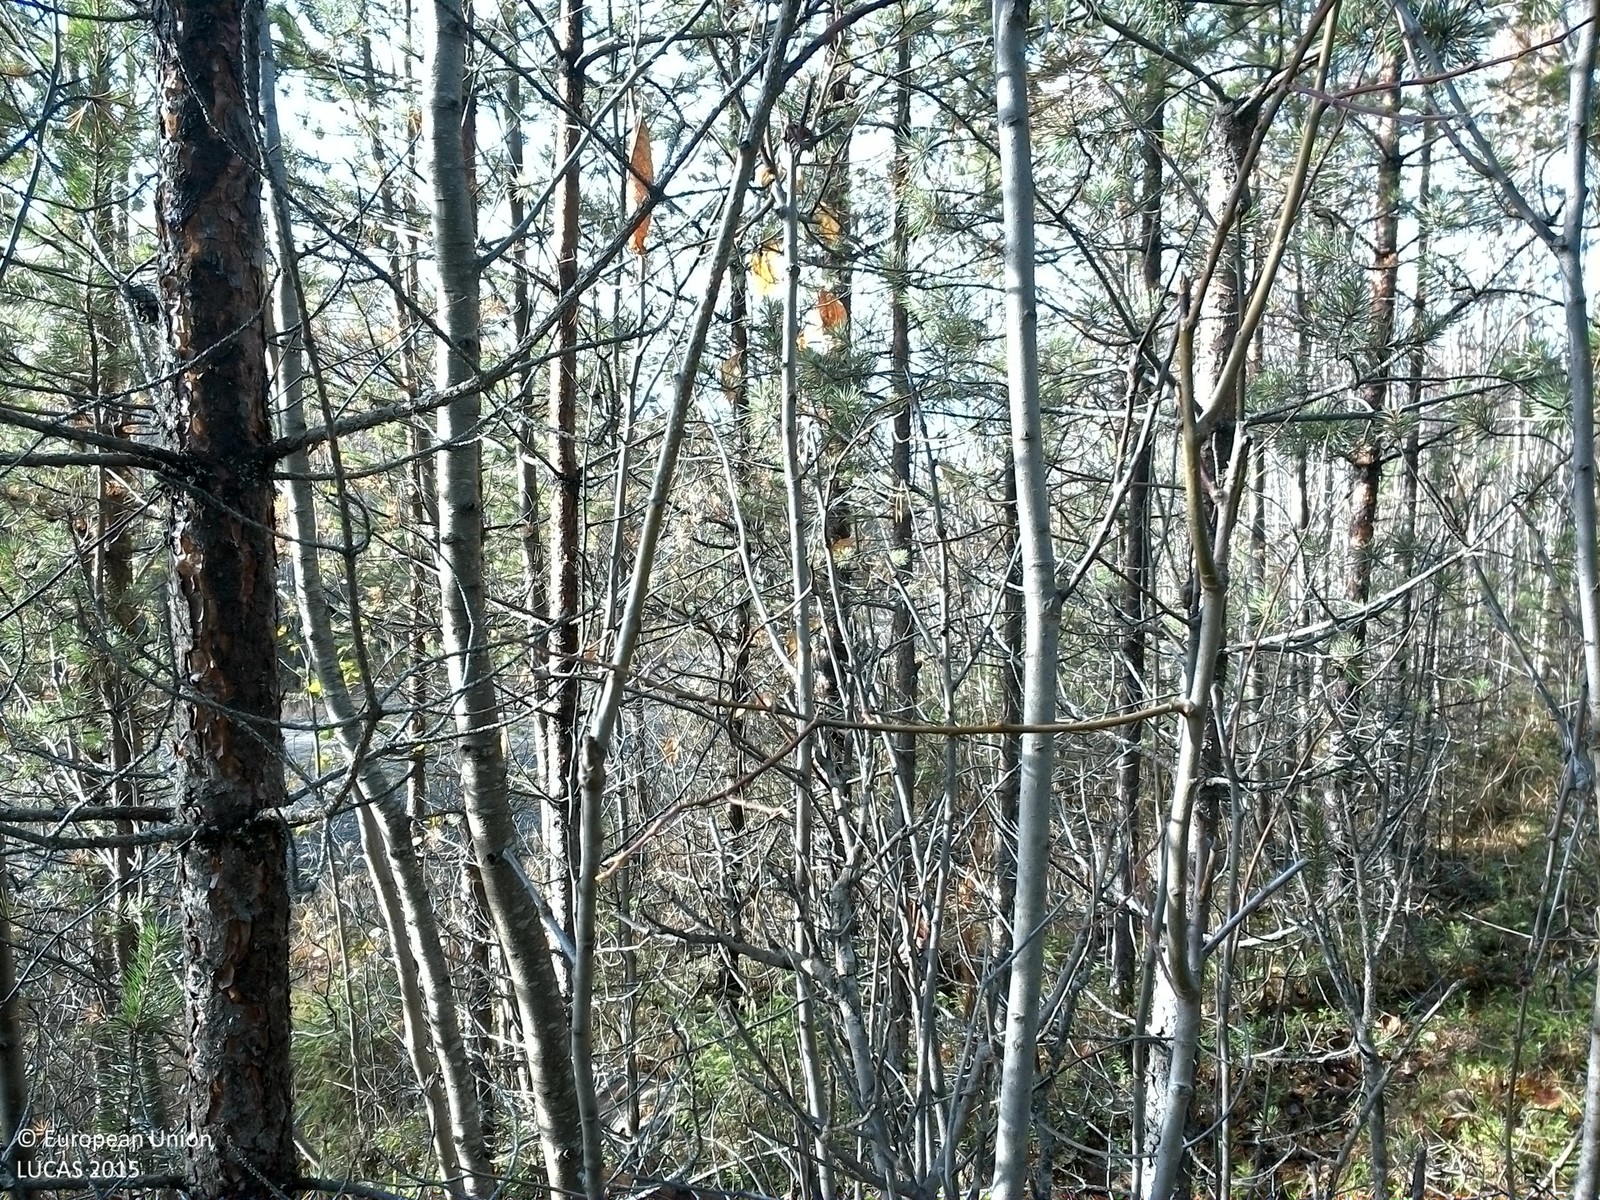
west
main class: Woodland
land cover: Pine dominated mixed woodland
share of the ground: 50 - 75 %
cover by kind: coniferous forest trees 35 %, shrubs 30 %, broadleaved forest trees 20 %, lichens and mosses 10 %, herbaceous plants 5 %
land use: Forestry
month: October
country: SE
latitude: 64.1011
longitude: 16.0653
